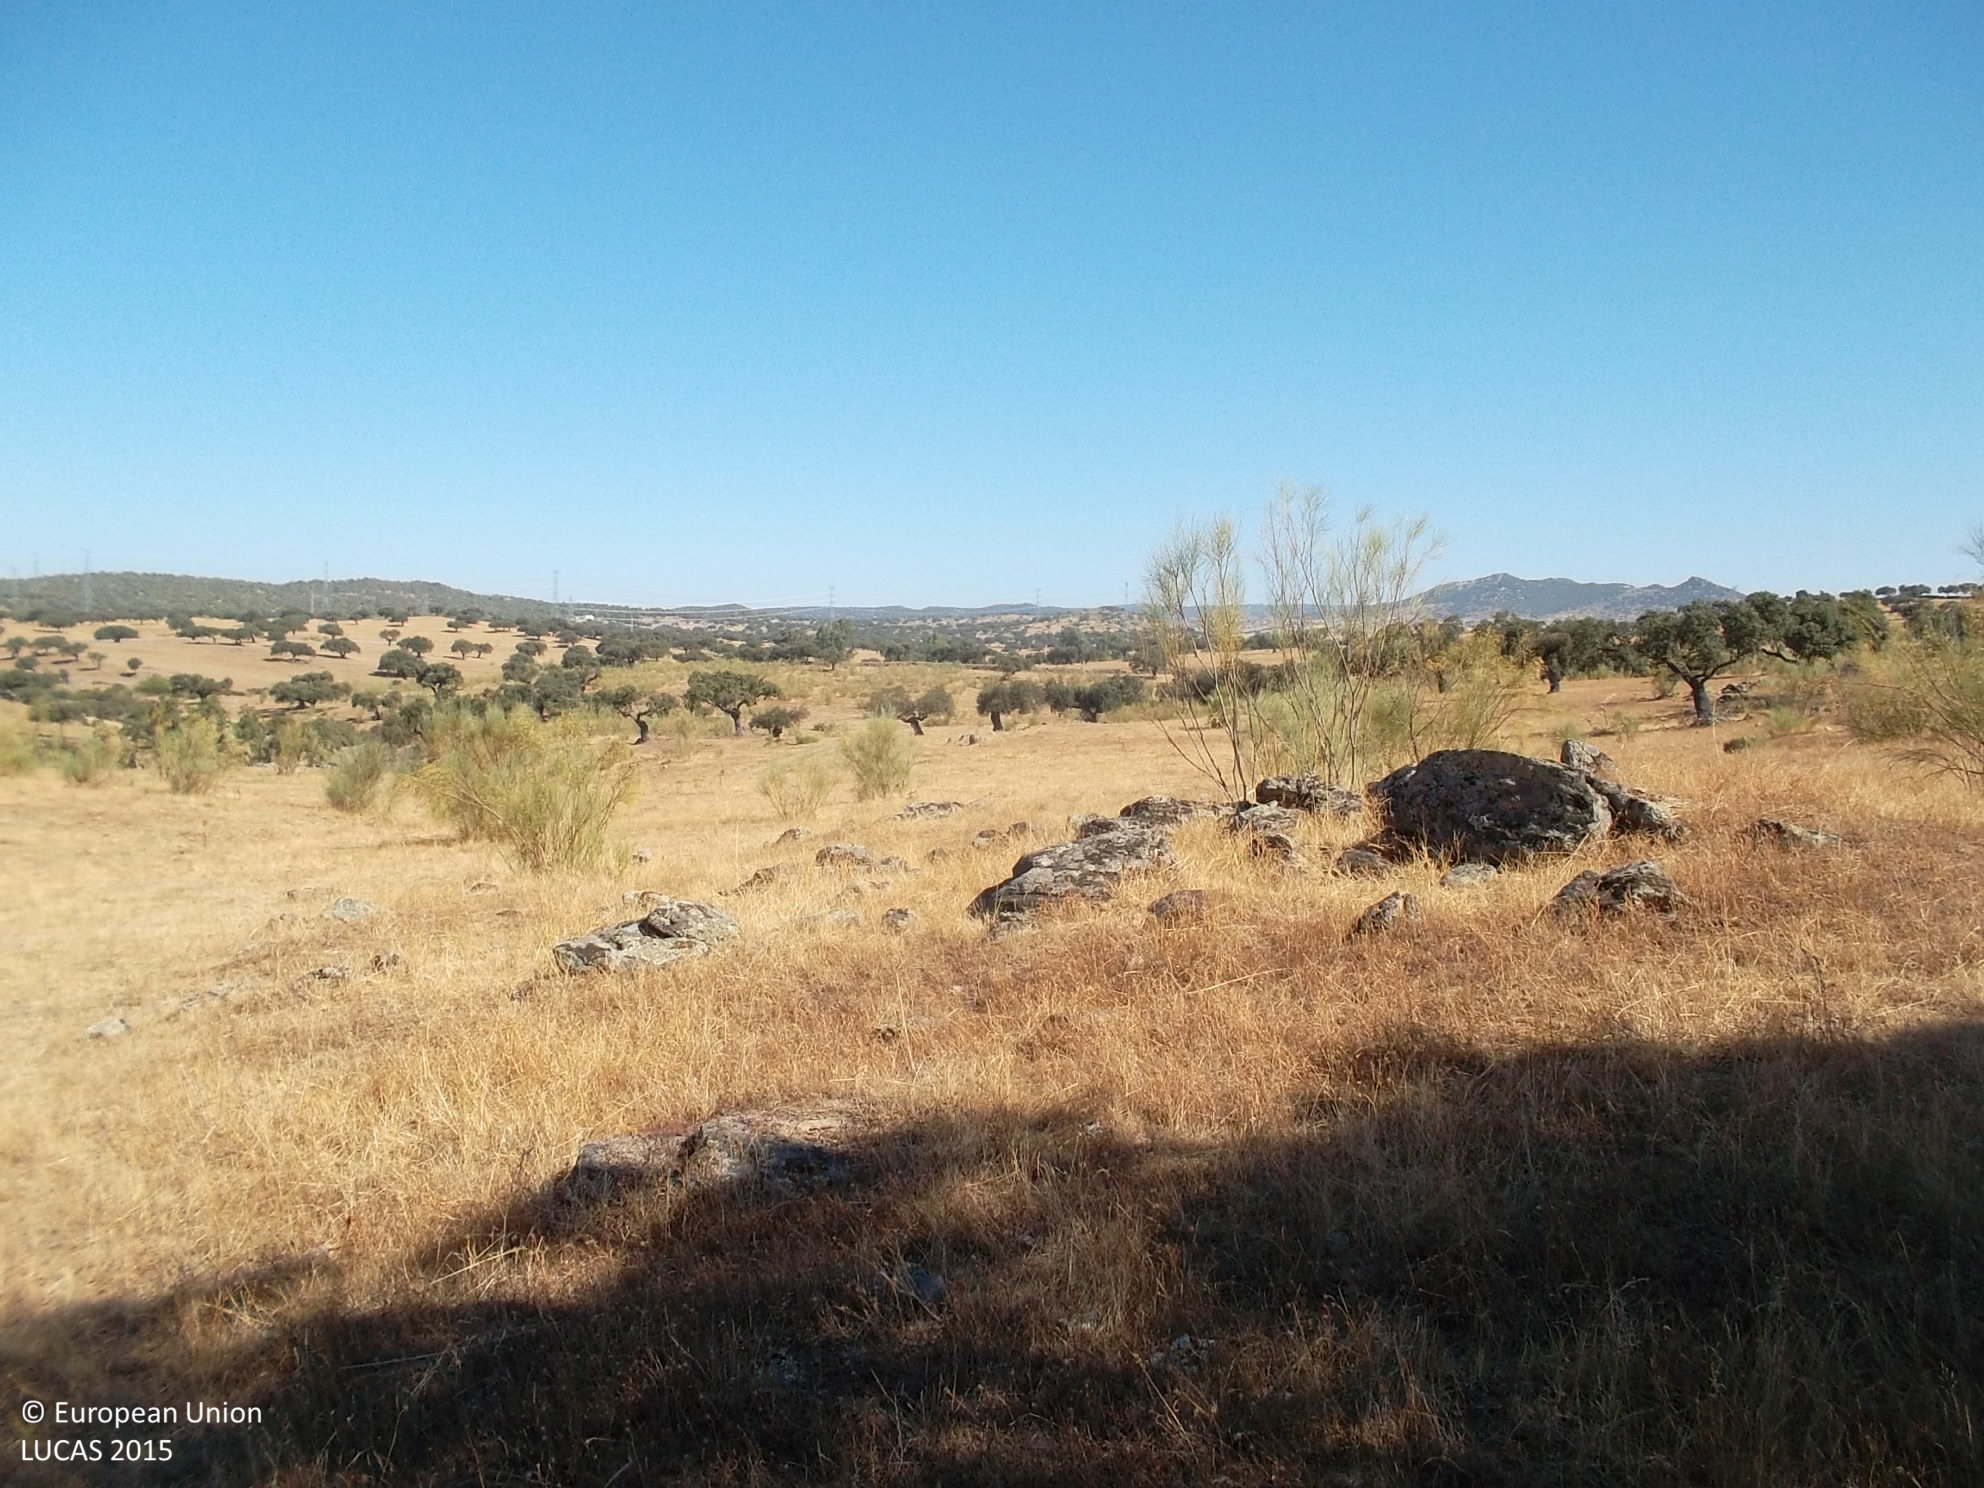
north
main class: Woodland
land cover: Broadleaved woodland
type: broadleaved evergreen forest
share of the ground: 10 - 25 %
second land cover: Grassland without tree/shrub cover
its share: > 75 %
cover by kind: herbaceous plants 85 %, broadleaved forest trees 15 %
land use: Forestry
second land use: Agriculture (excluding fallow land and kitchen gardens)
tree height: > 5 m
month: August
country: ES
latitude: 38.3173
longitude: -6.6487
